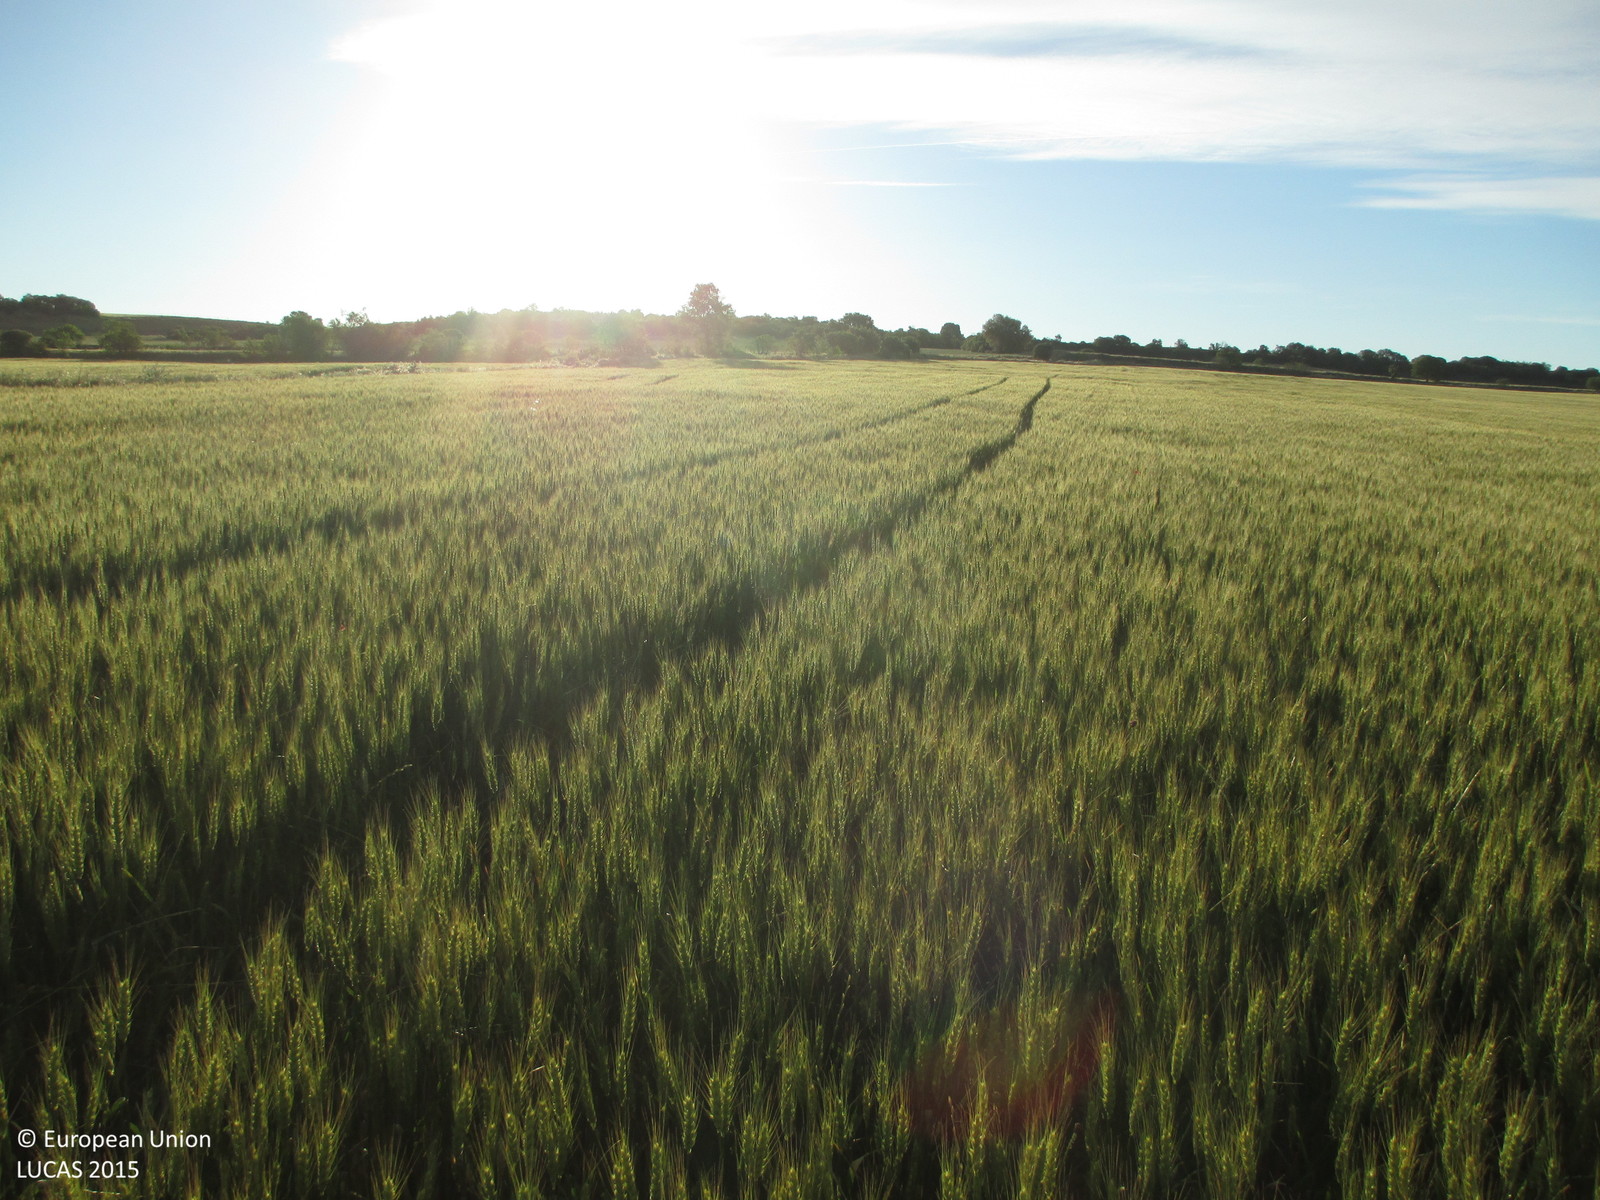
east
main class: Cropland
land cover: Durum wheat
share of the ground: > 75 %
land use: Agriculture (excluding fallow land and kitchen gardens)
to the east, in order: Durum wheat; Shruby margins; Ditches and canals; Shruby margins; Single bushes/trees; Common wheat
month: May
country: ES
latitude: 42.1105
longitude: -0.2891
